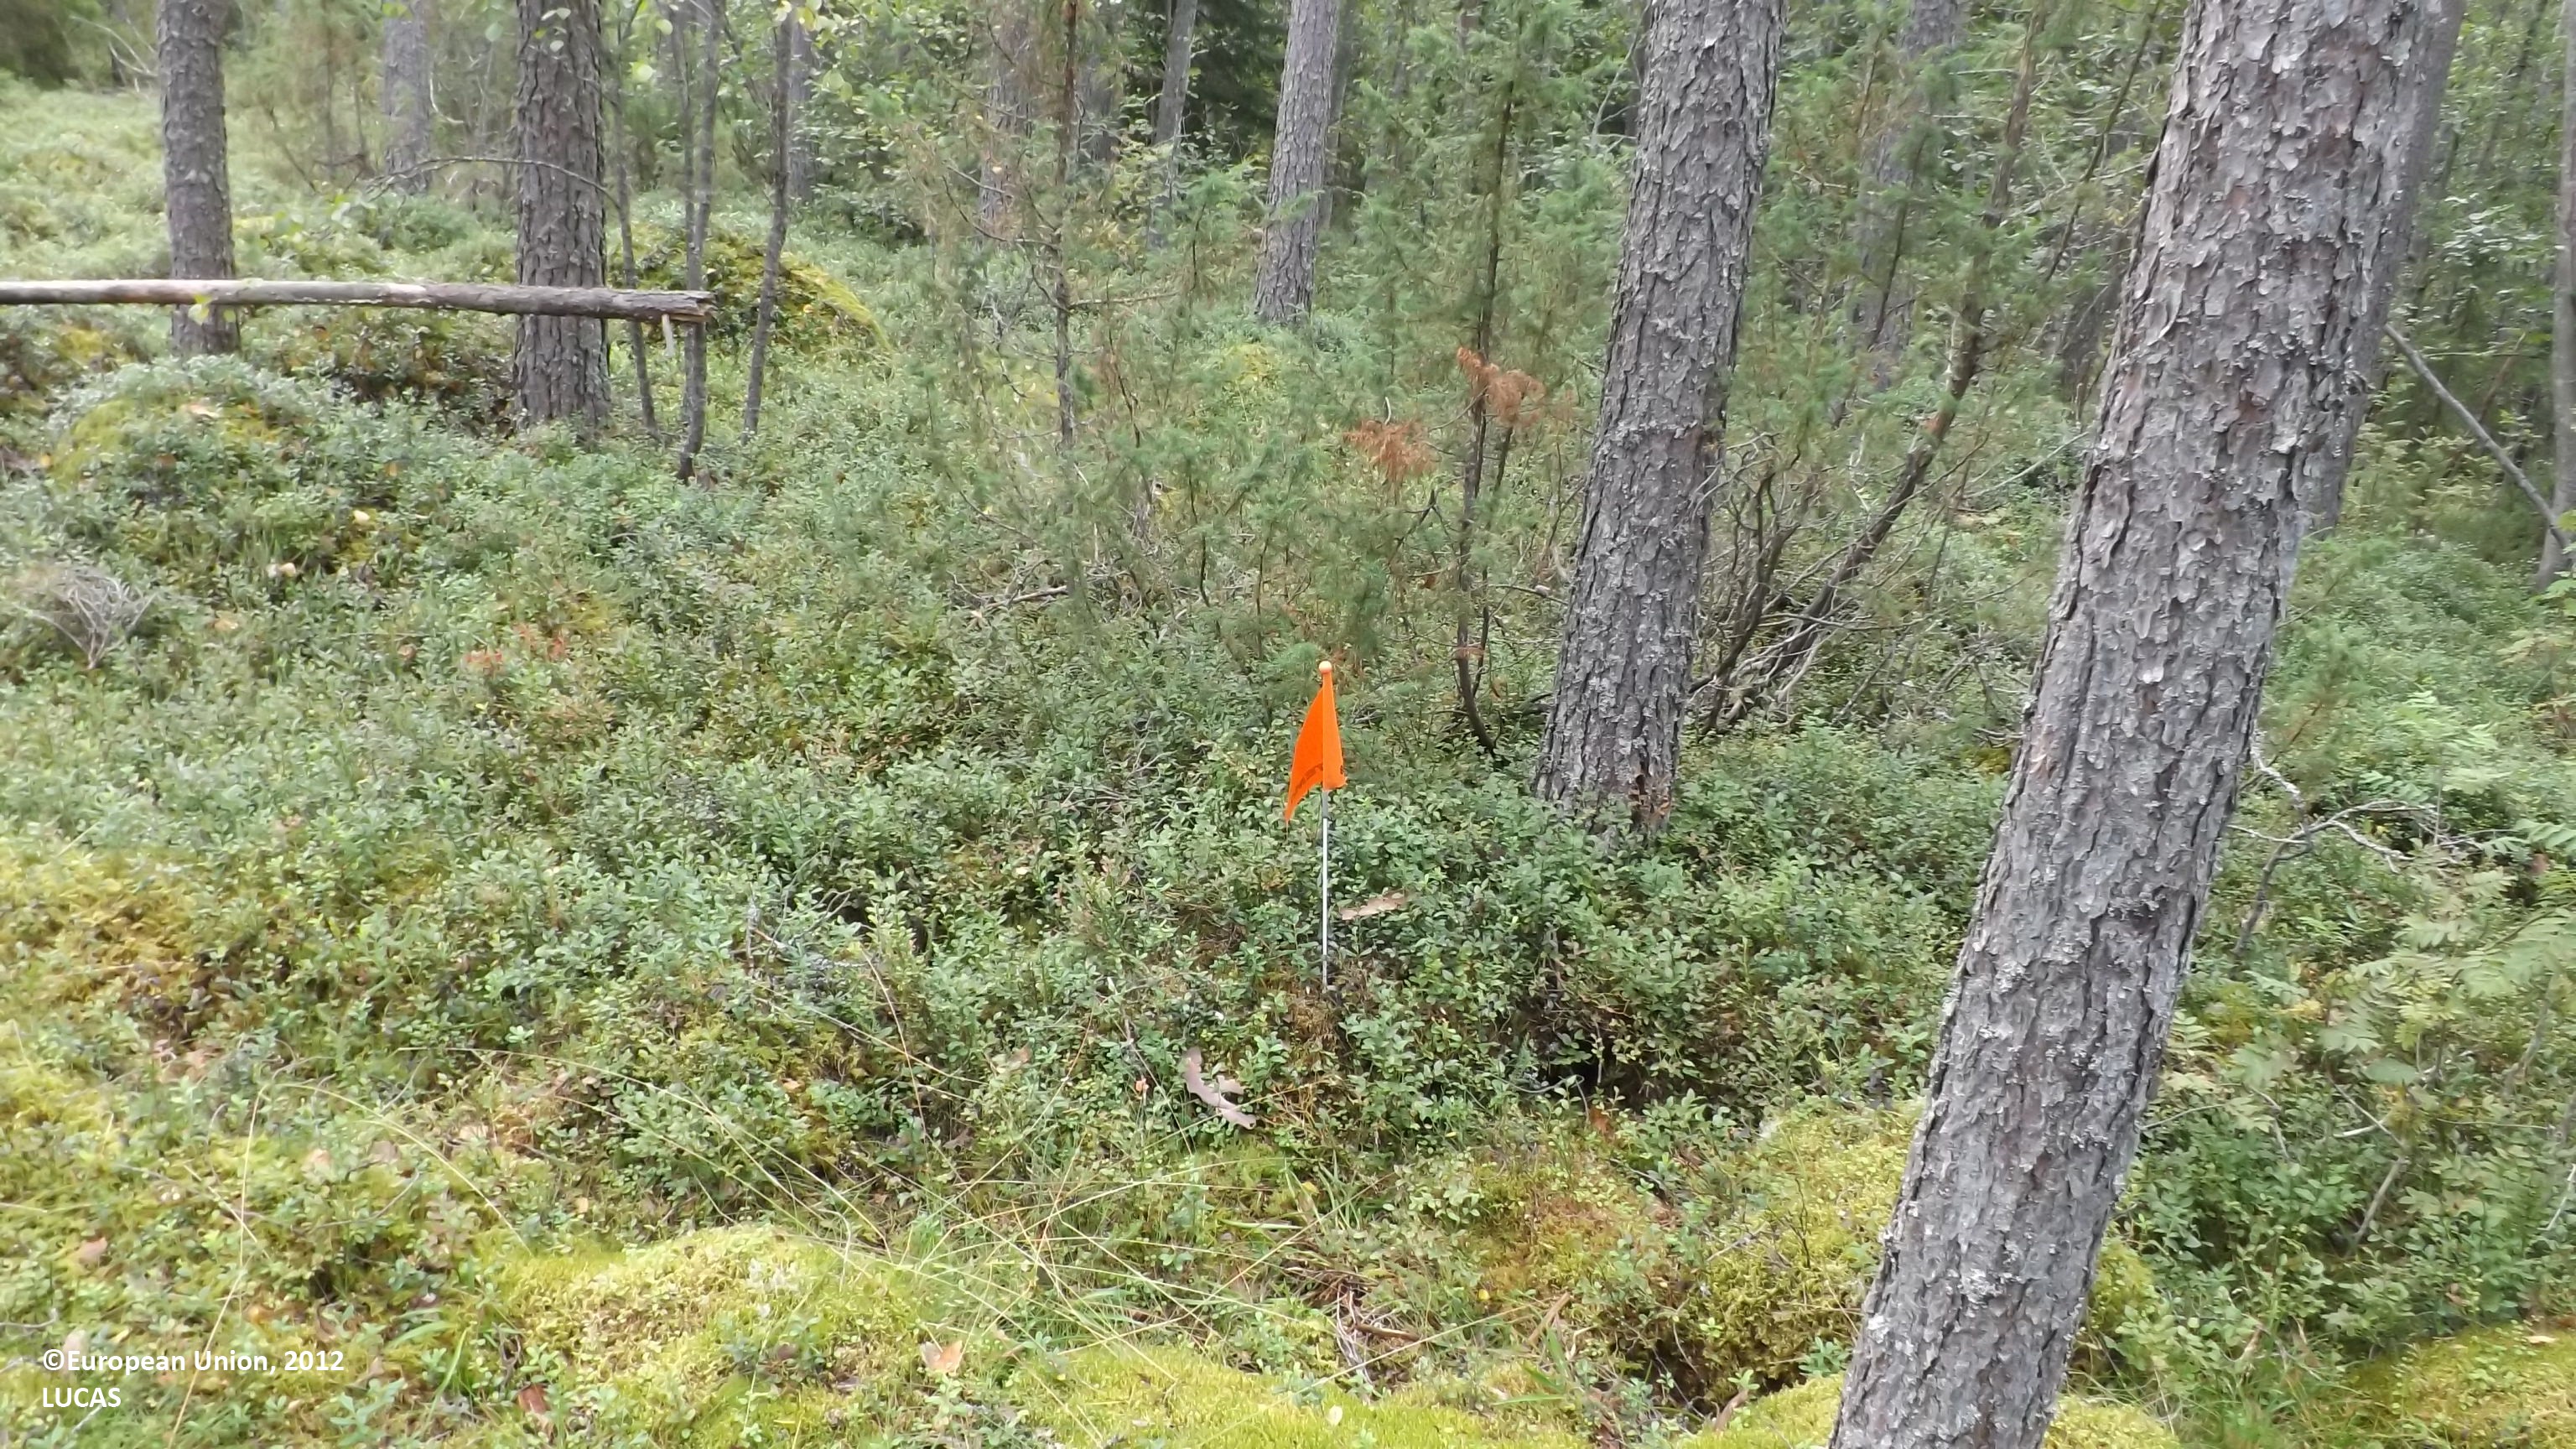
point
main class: Woodland
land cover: Pine dominated mixed woodland
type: boreal forest
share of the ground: 25 - 50 %
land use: Forestry
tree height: > 5 m
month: August
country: FI
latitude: 63.7170
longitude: 24.0150
